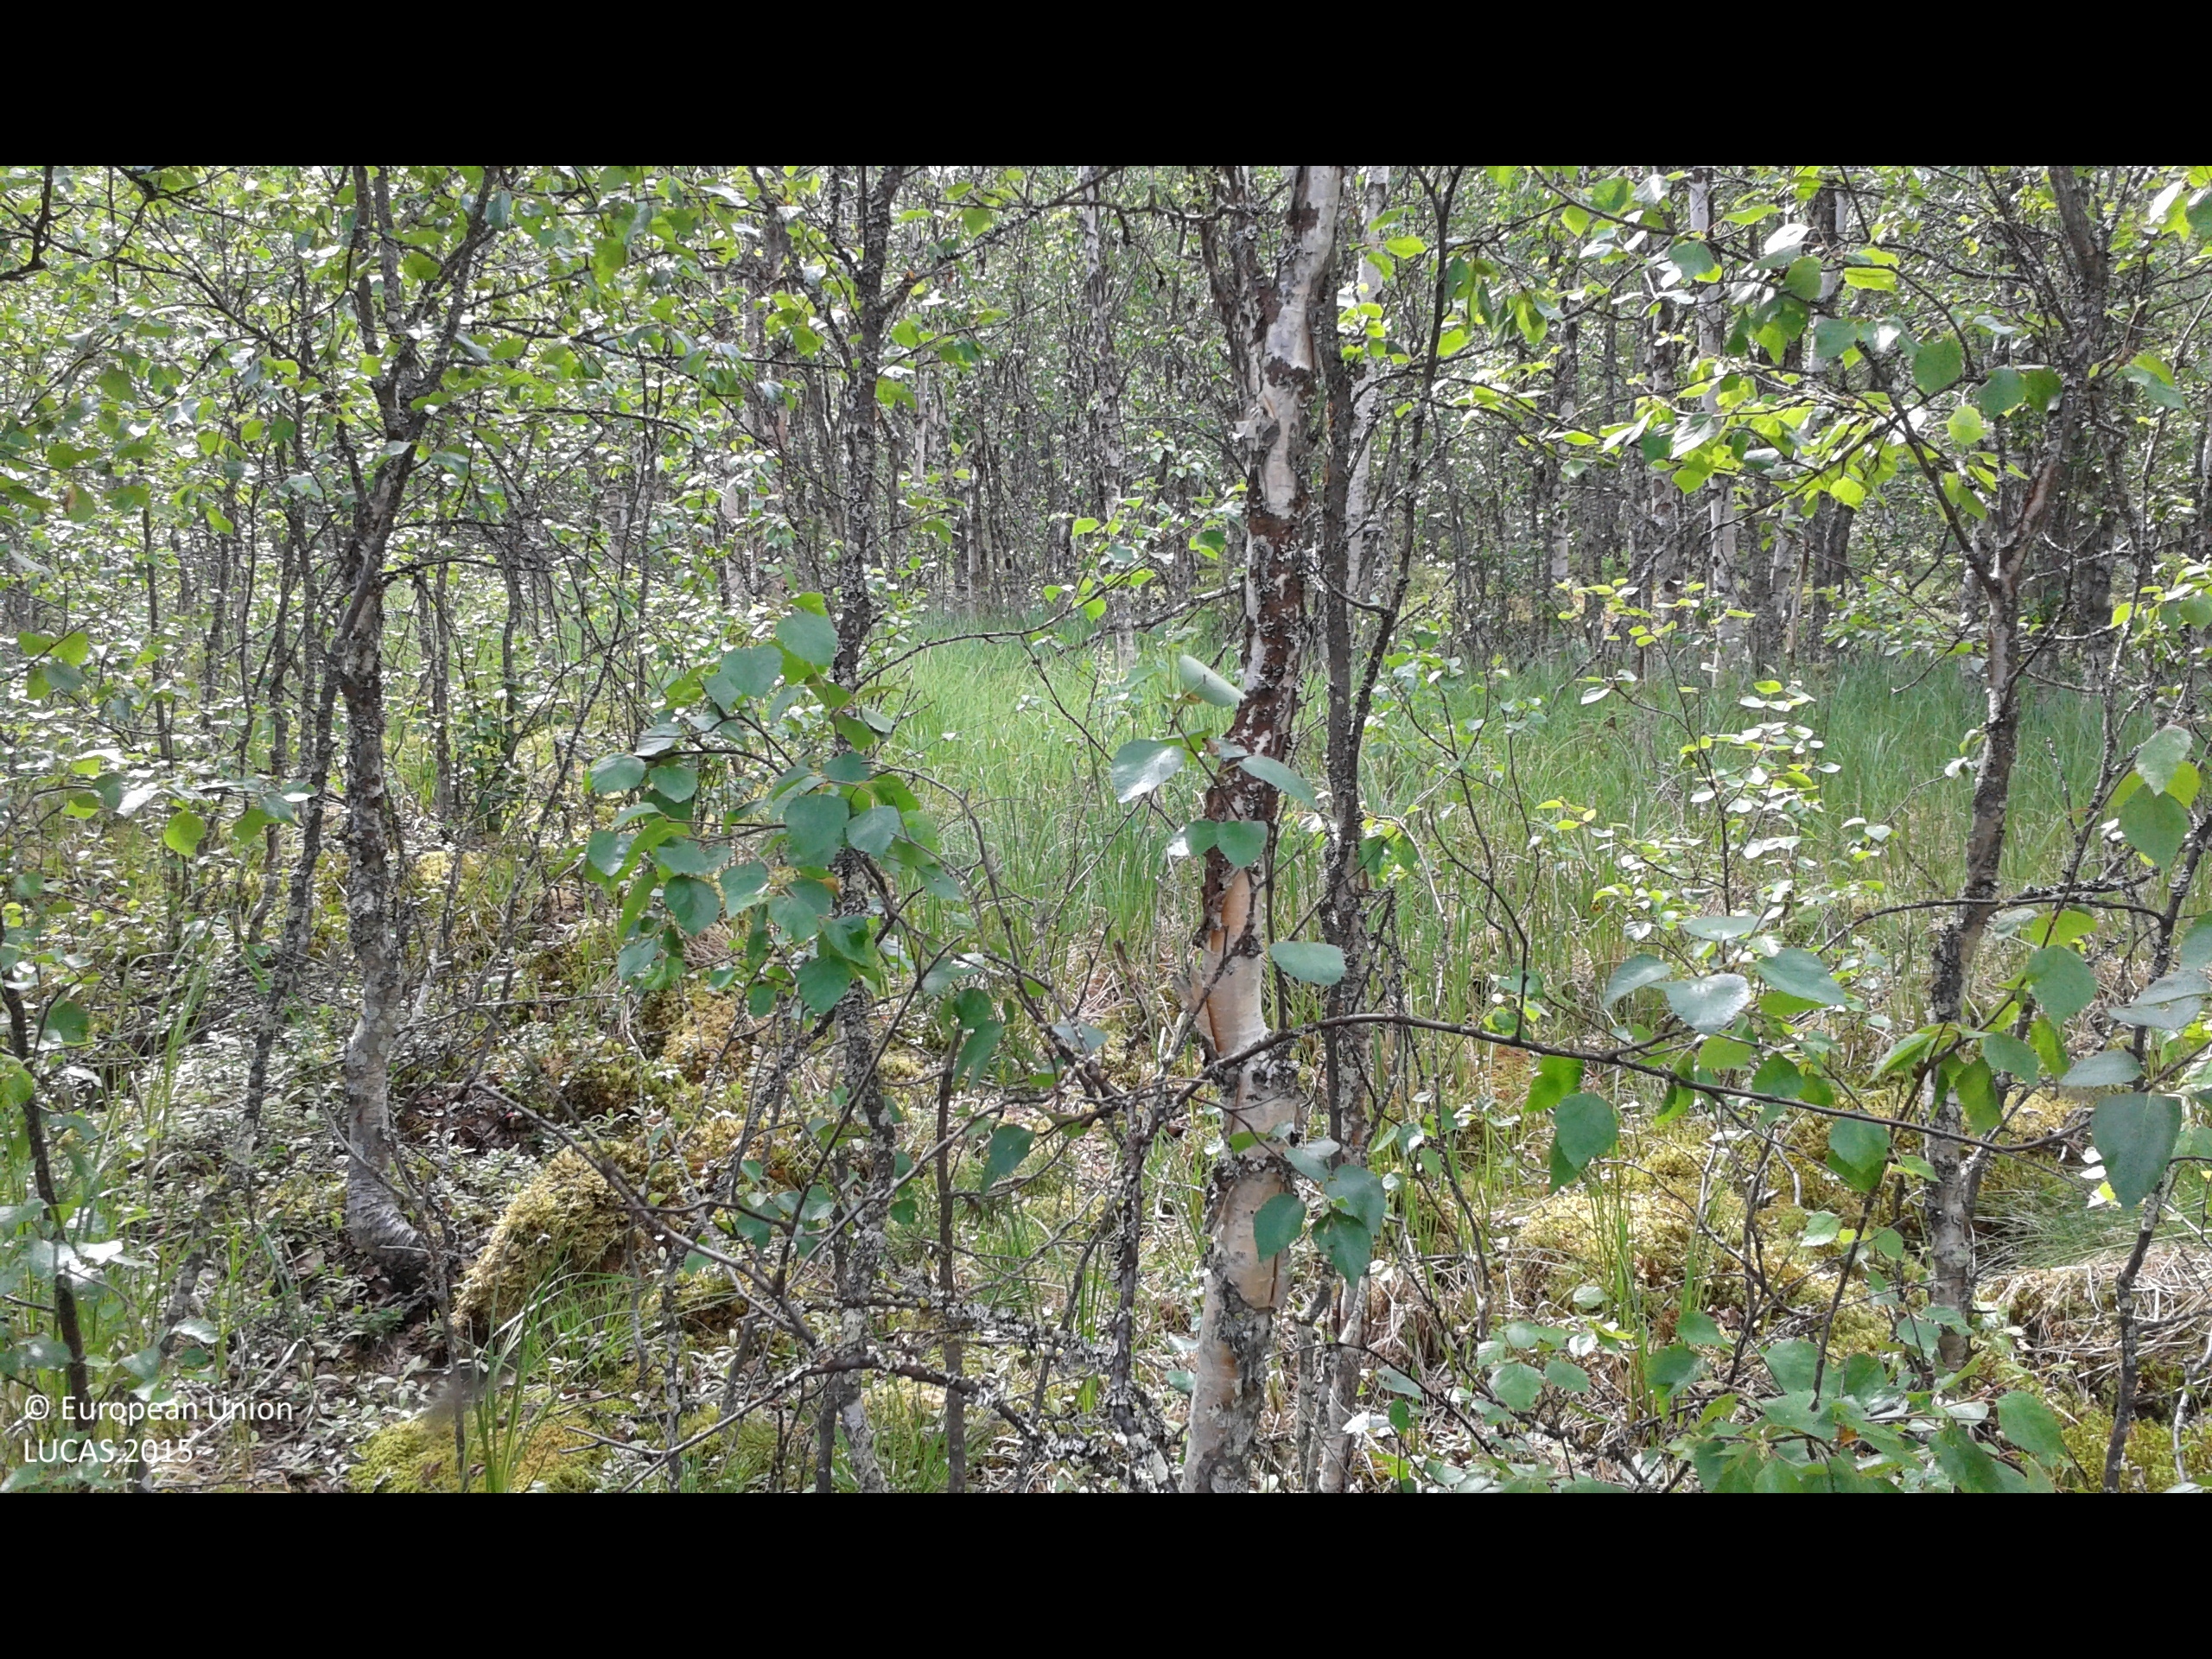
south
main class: Woodland
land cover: Broadleaved woodland
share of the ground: 25 - 50 %
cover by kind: herbaceous plants 40 %, broadleaved forest trees 30 %, lichens and mosses 30 %
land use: Forestry
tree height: > 5 m
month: July
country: SE
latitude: 67.0137
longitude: 23.1206
